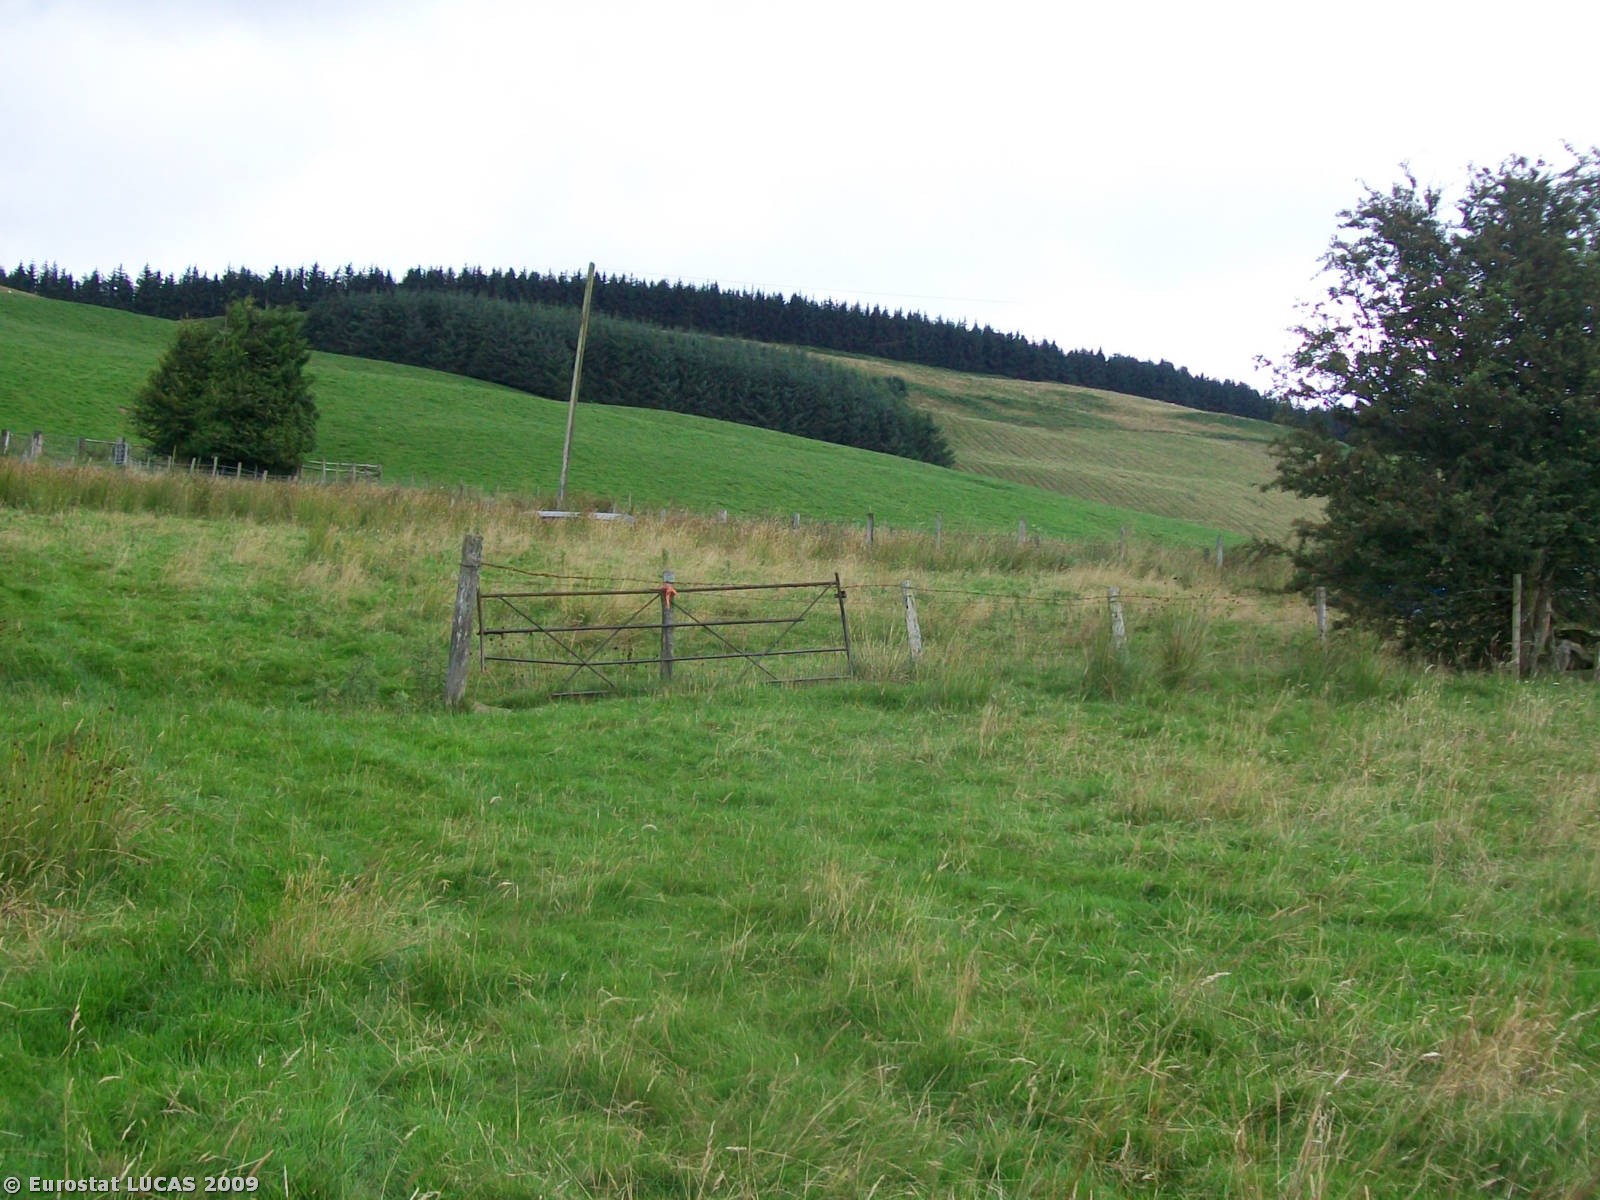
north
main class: Grassland
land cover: Grassland without tree/shrub cover
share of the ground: > 75 %
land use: Agriculture (excluding fallow land and kitchen gardens)
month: August
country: GB
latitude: 52.7616
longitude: -3.4047
